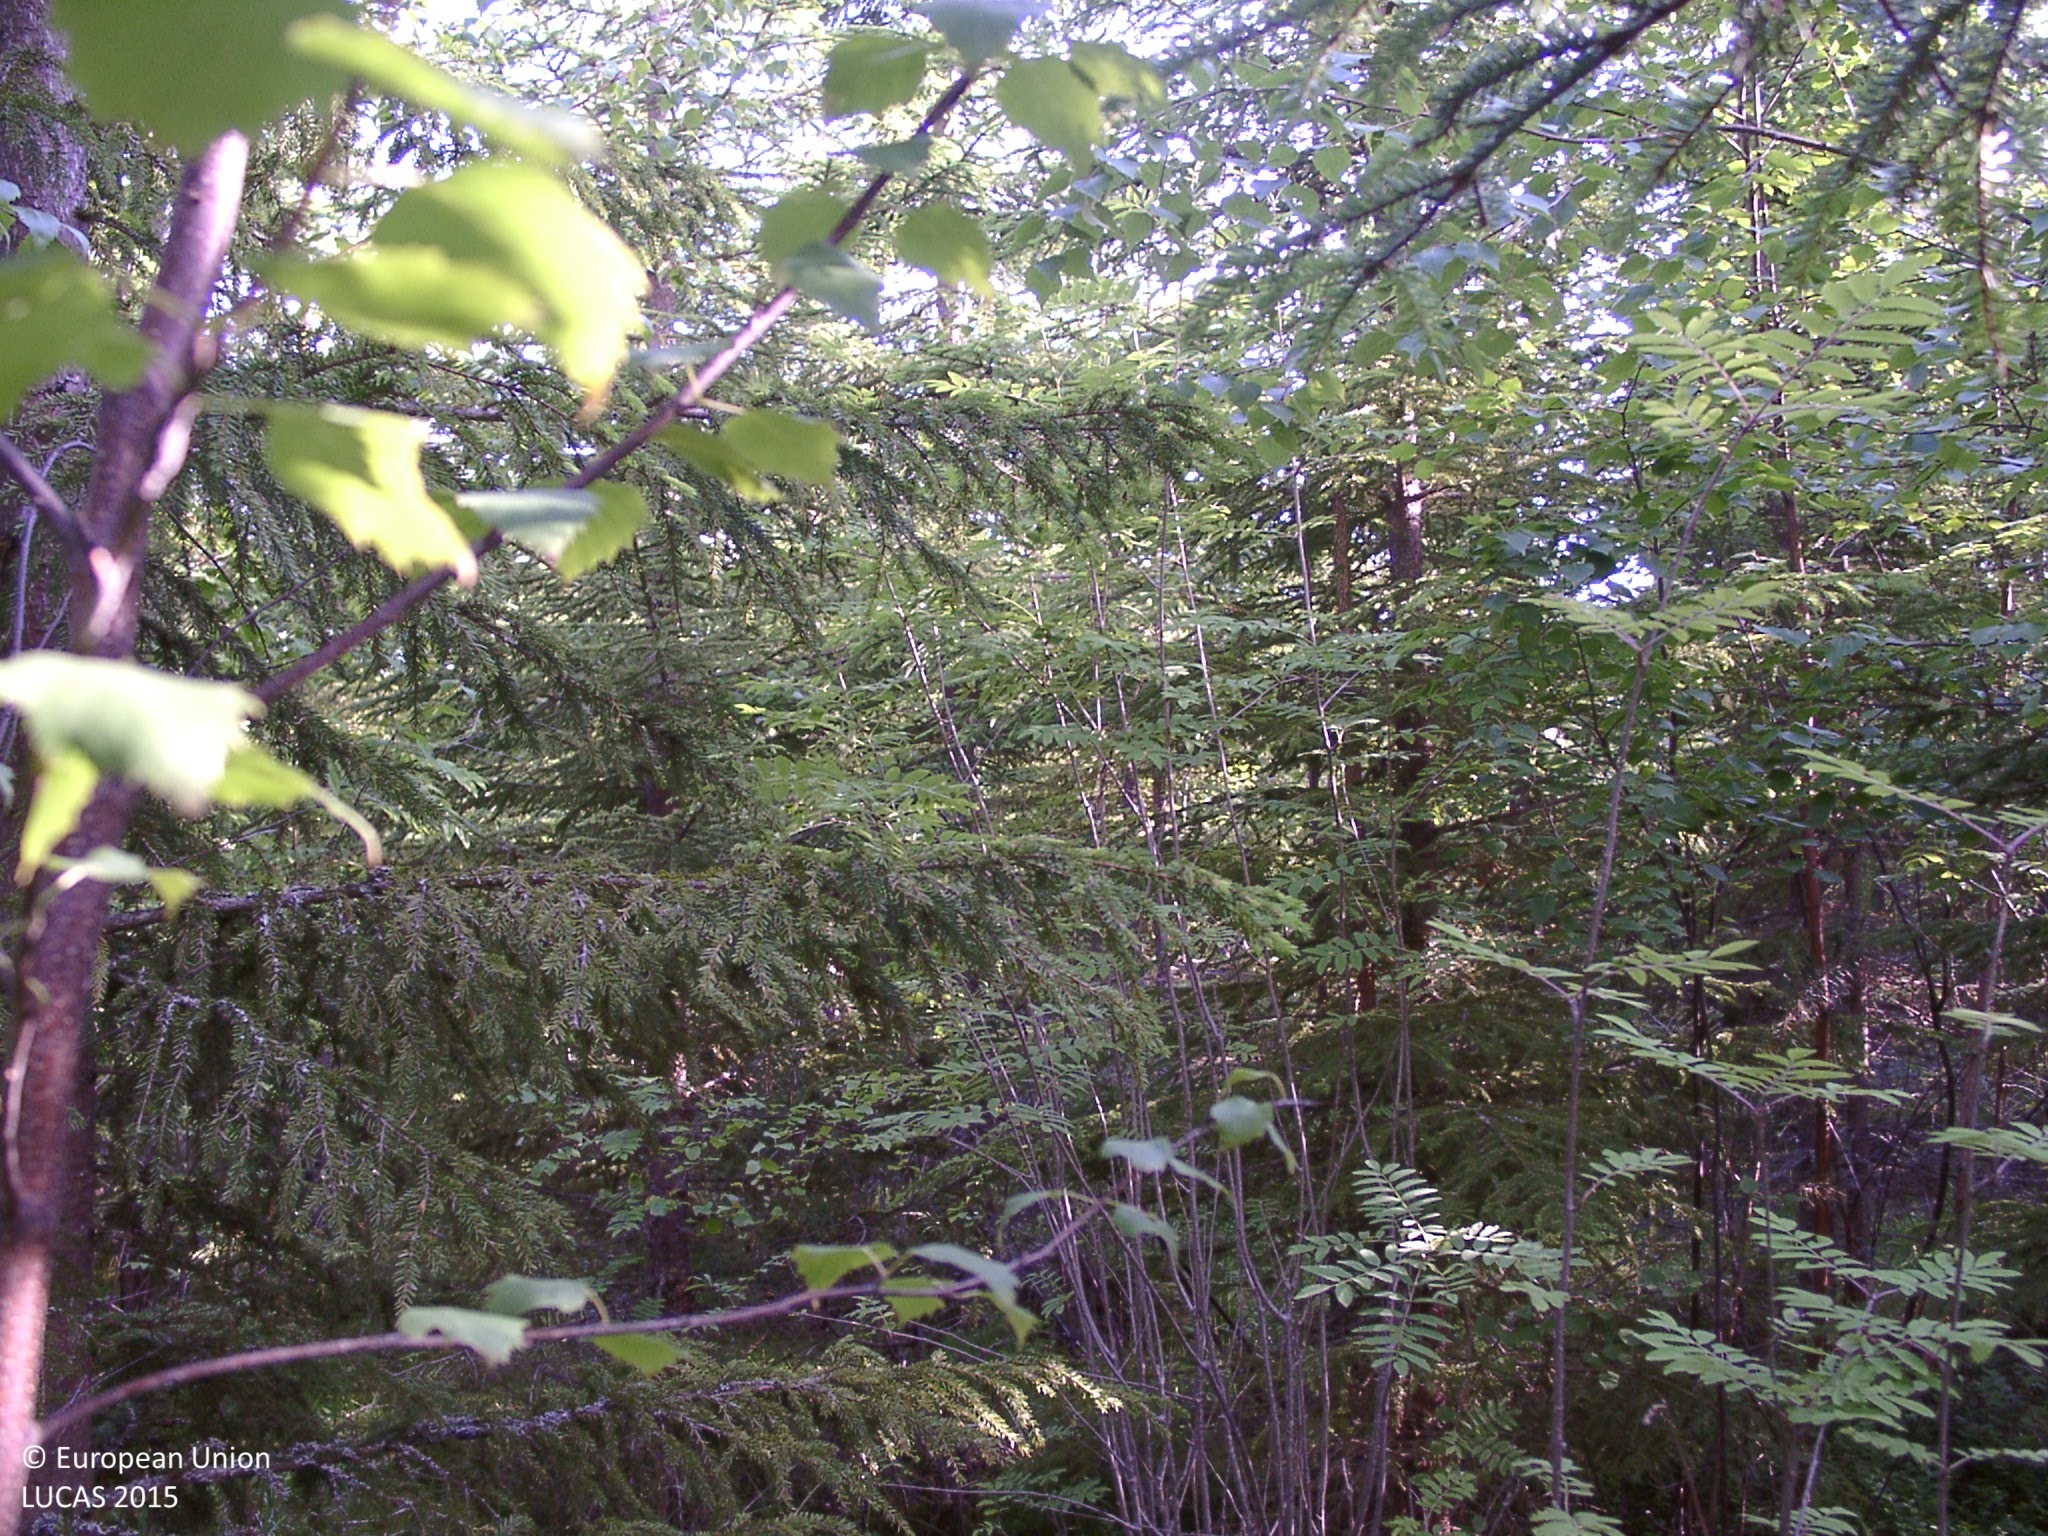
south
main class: Woodland
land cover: Spruce dominated mixed woodland
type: boreal forest
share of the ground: > 75 %
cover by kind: broadleaved forest trees 45 %, coniferous forest trees 40 %, shrubs 5 %, herbaceous plants 5 %, lichens and mosses 5 %
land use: Forestry
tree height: < 5 m
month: July
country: FI
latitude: 62.2456
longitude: 25.1392
